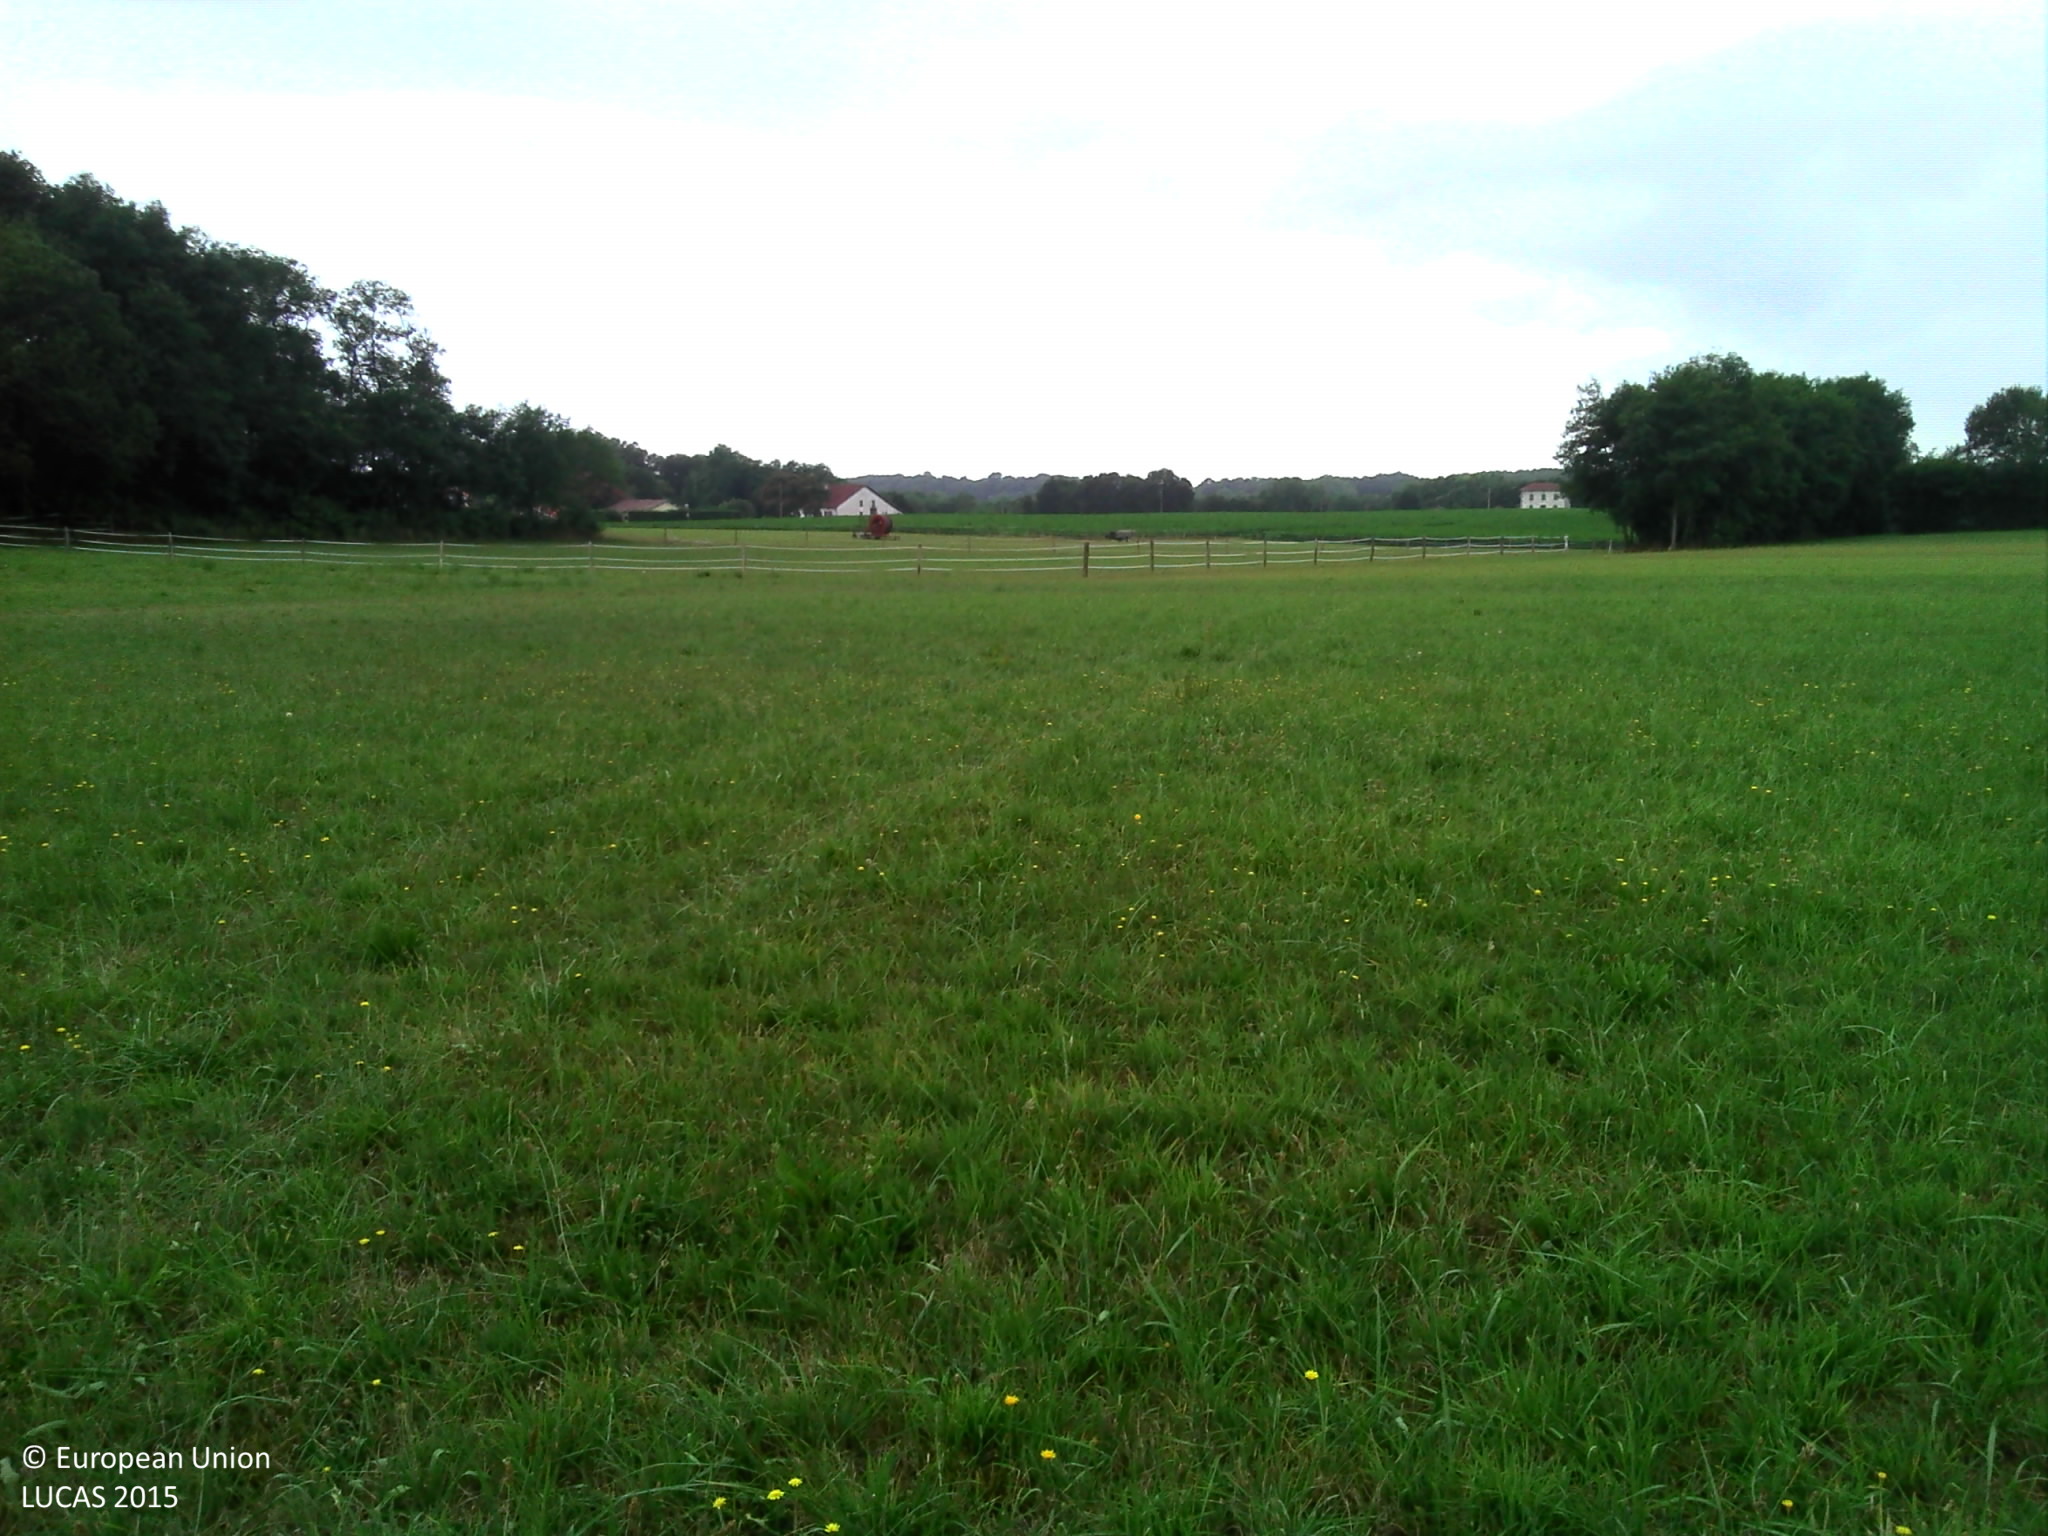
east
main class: Grassland
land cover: Grassland without tree/shrub cover
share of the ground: > 75 %
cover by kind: herbaceous plants 100 %
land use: Agriculture (excluding fallow land and kitchen gardens)
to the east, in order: Grassland without tree/shrub cover; Tracks; Grassland without tree/shrub cover; Soya
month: July
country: FR
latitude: 43.6321
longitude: -1.2089
